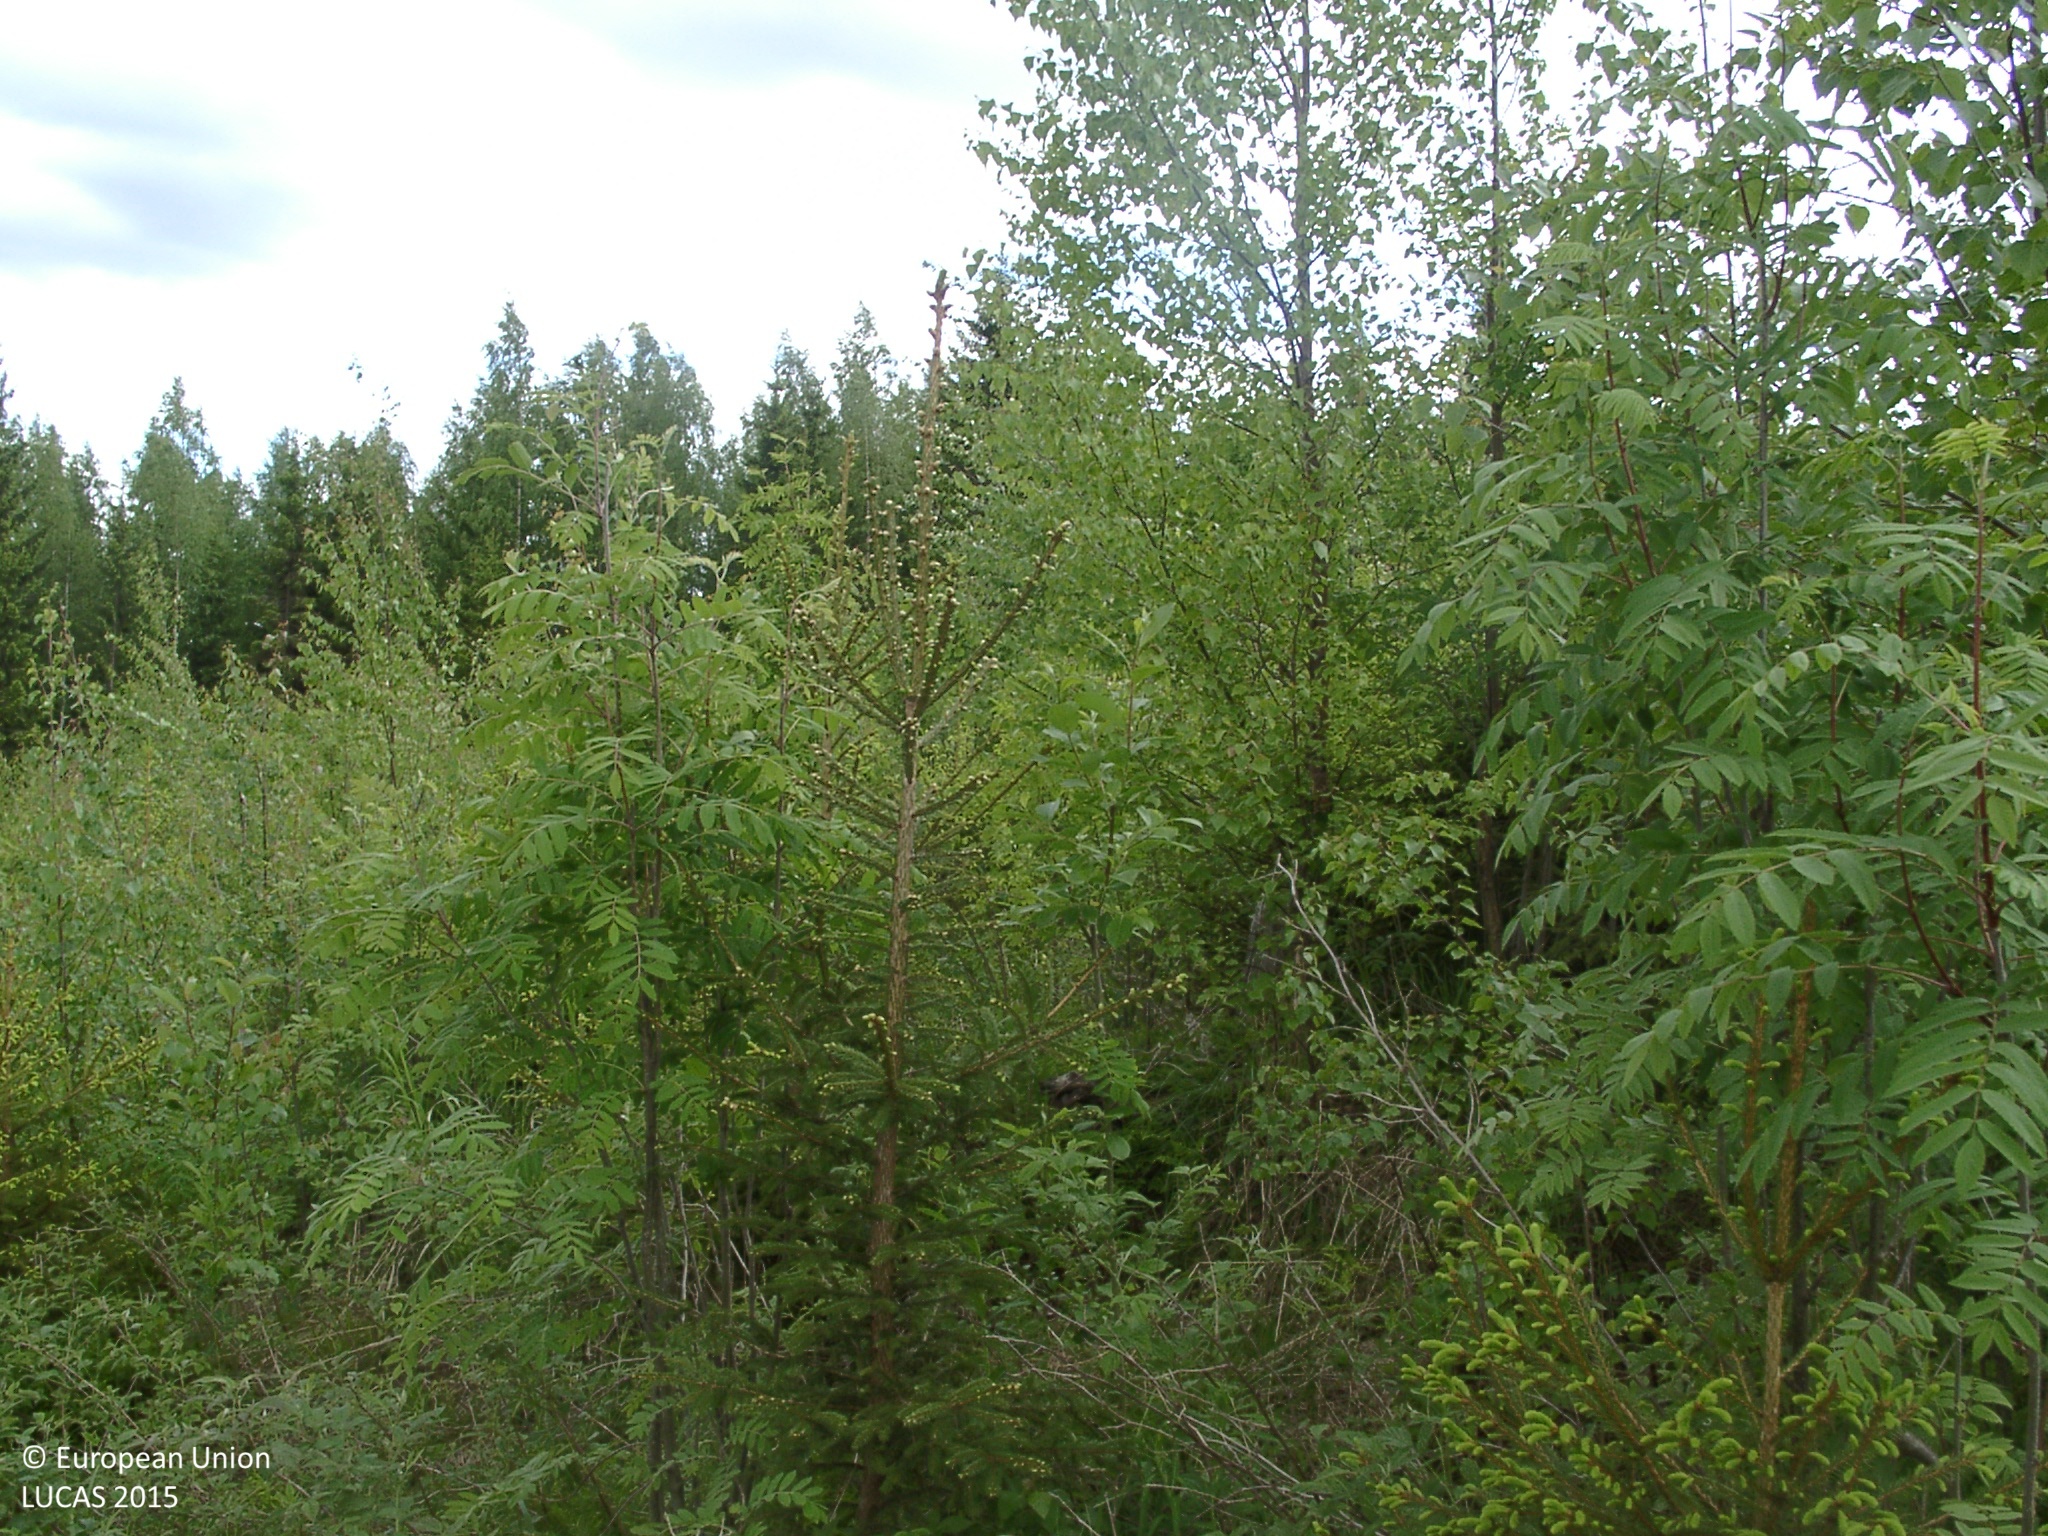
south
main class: Woodland
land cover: Spruce dominated mixed woodland
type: boreal forest
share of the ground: 50 - 75 %
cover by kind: broadleaved forest trees 45 %, coniferous forest trees 25 %, shrubs 15 %, herbaceous plants 15 %
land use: Forestry
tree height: < 5 m
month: June
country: FI
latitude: 62.4532
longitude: 25.7997
